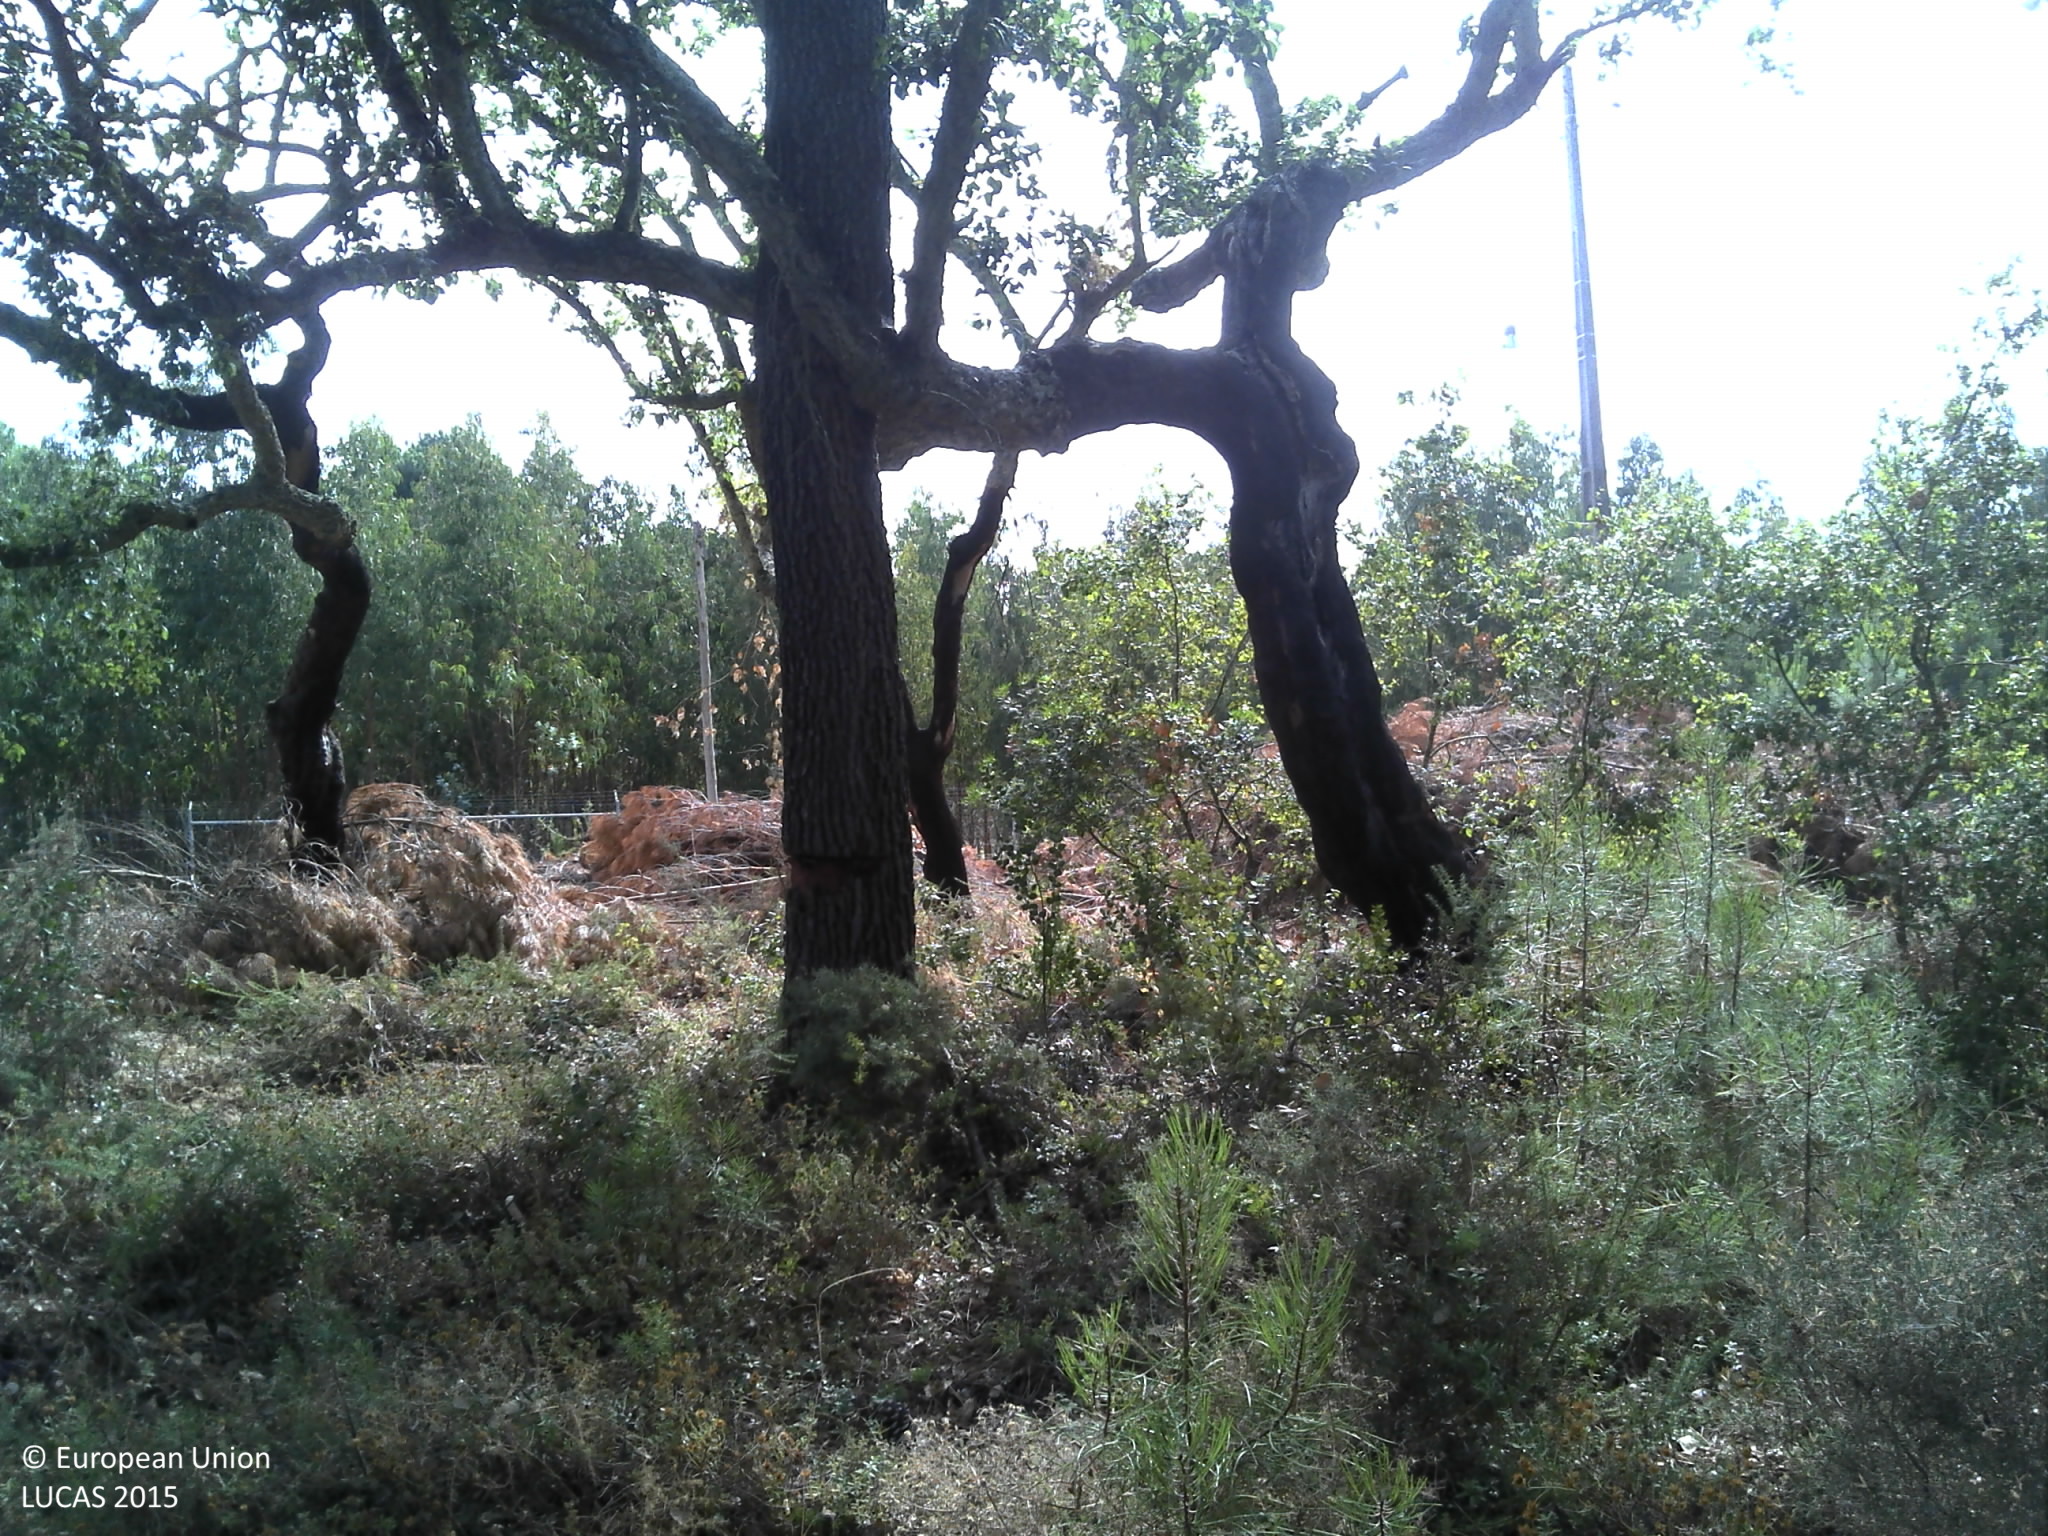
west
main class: Woodland
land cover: Pine dominated mixed woodland
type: coniferous forest of the mediterranean region
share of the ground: 50 - 75 %
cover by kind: coniferous forest trees 35 %, broadleaved forest trees 30 %, shrubs 20 %, unconsolidated bare surface 15 %
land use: Forestry
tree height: > 5 m
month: June
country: PT
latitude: 38.4802
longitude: -9.1098
